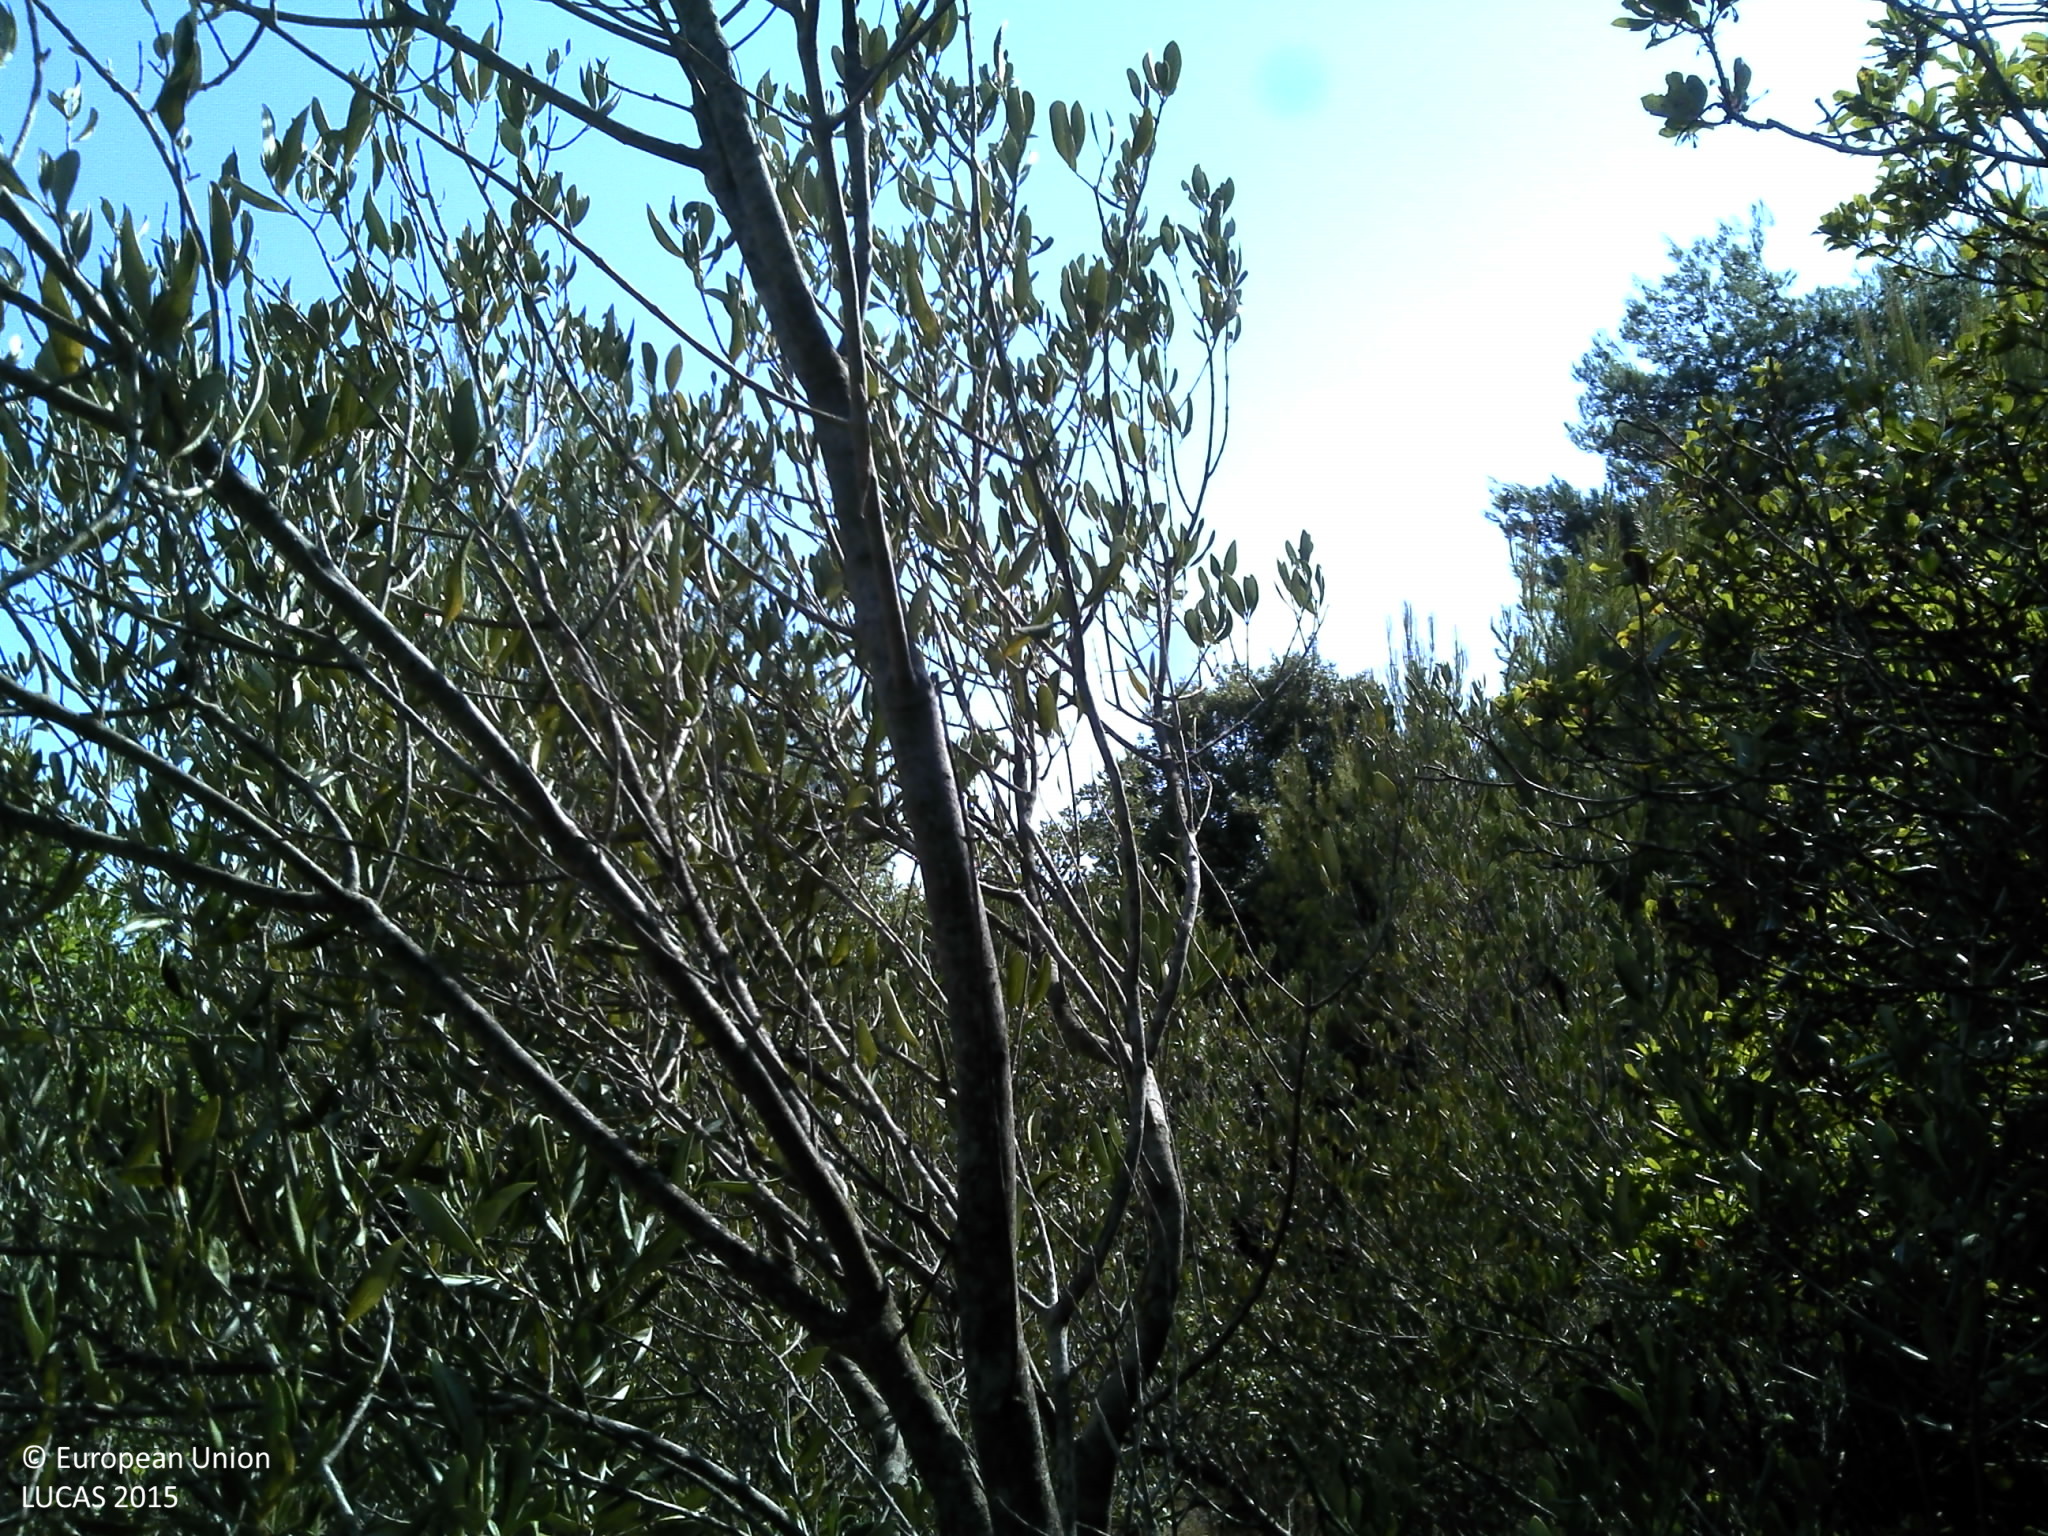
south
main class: Cropland
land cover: Olive groves
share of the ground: > 75 %
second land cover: Shrubland without tree cover
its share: > 75 %
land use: Agriculture (excluding fallow land and kitchen gardens)
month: August
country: HR
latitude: 42.9234
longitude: 16.9355
